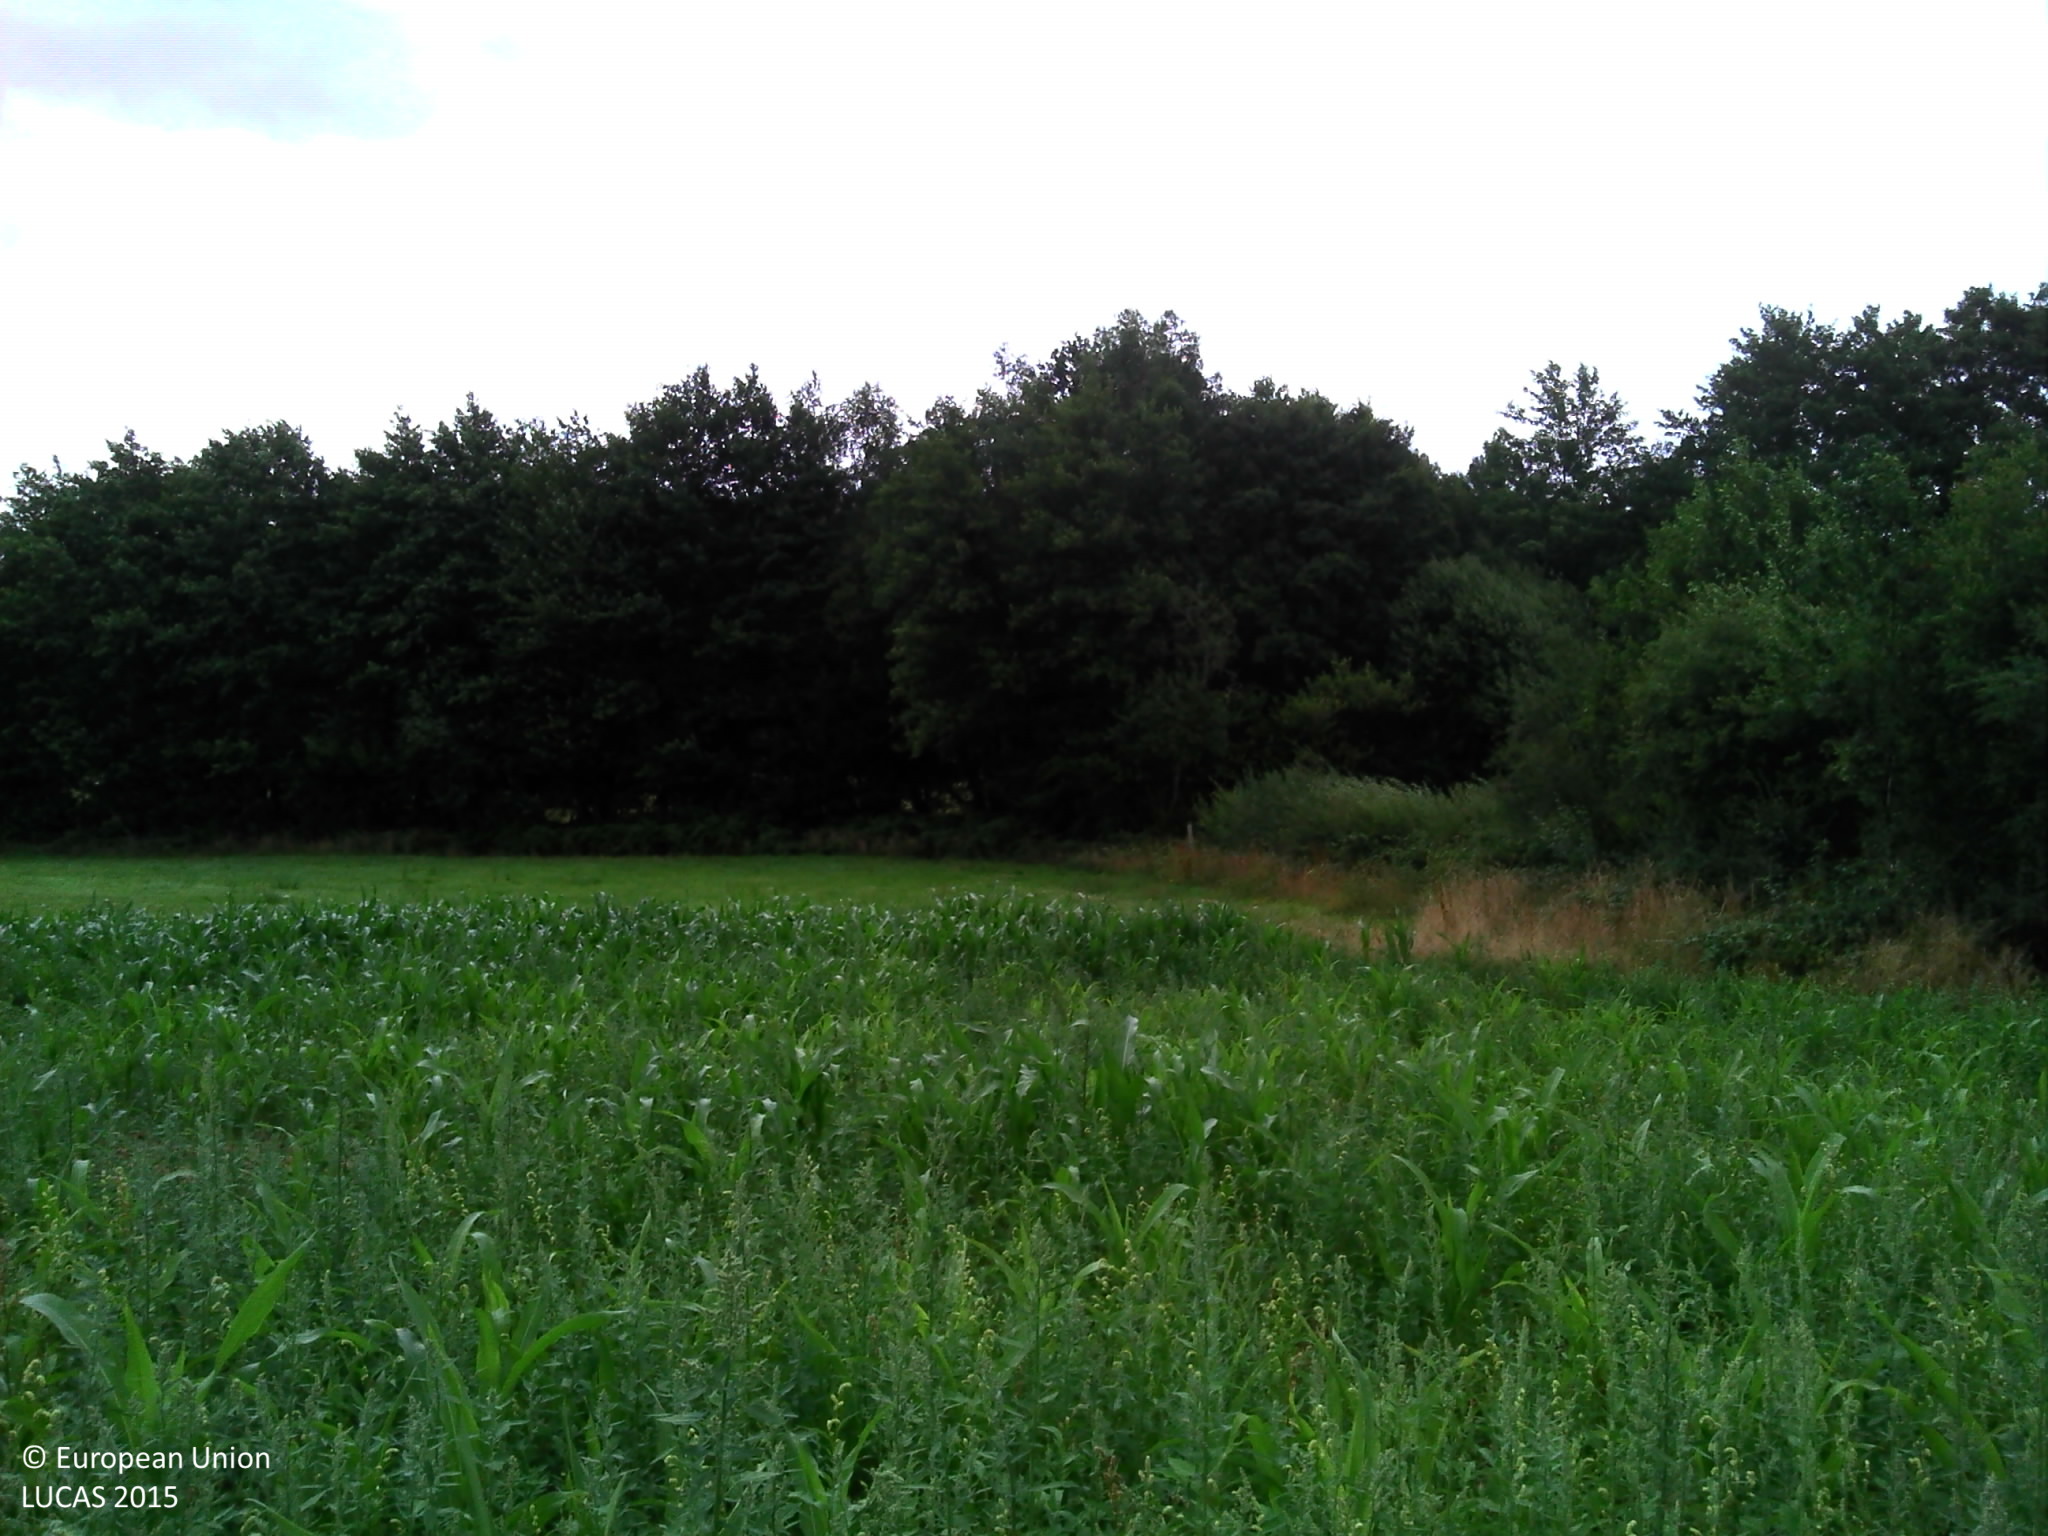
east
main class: Cropland
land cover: Maize
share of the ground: > 75 %
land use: Agriculture (excluding fallow land and kitchen gardens)
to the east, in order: Maize; Temporary grasslands; Managed hedges; Rivers and streams; Managed hedges; Fences; Grassland without tree/shrub cover; Fences; Managed hedges; Grass margins; Tracks; Grass margins; Fences; Broadleaved woodland; Fences; Arable land (only in case pi)
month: July
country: FR
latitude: 48.3865
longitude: -0.1722
